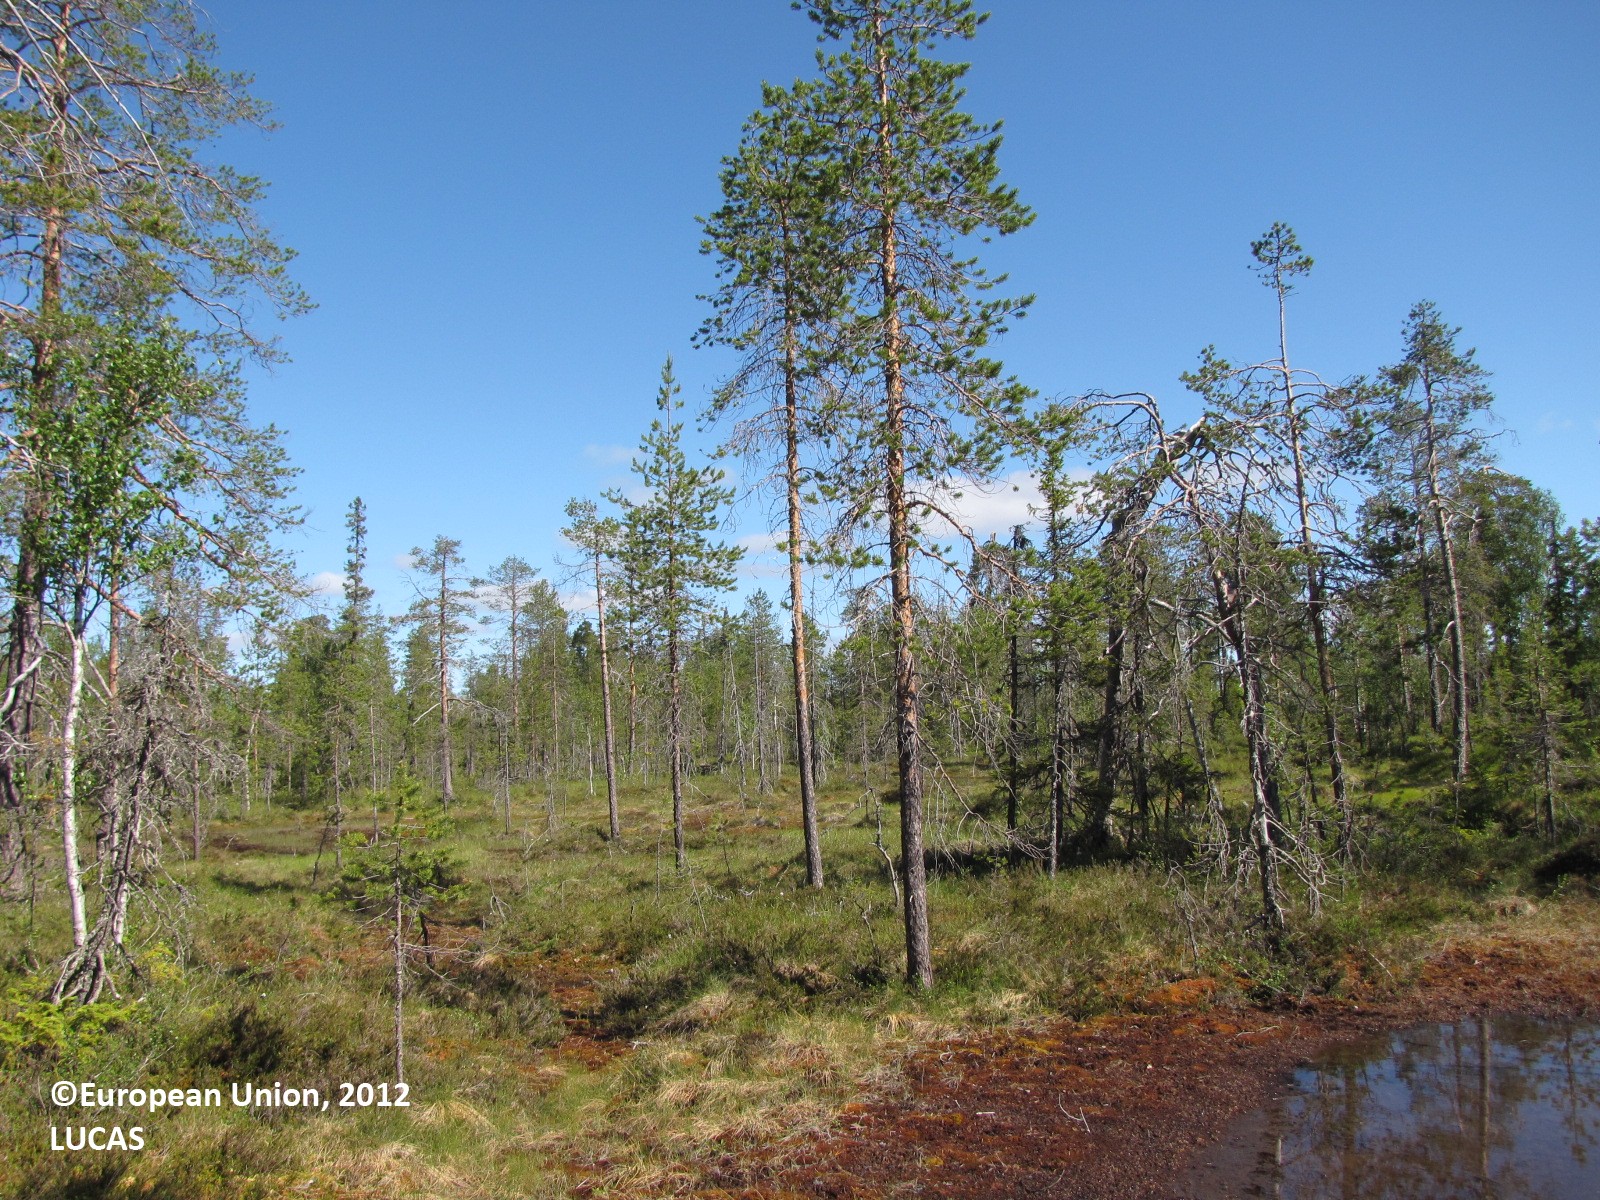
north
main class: Woodland
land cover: Pine dominated coniferous woodland
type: boreal forest
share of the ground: 25 - 50 %
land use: Forestry
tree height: > 5 m
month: July
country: FI
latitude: 66.4659
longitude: 24.8414
